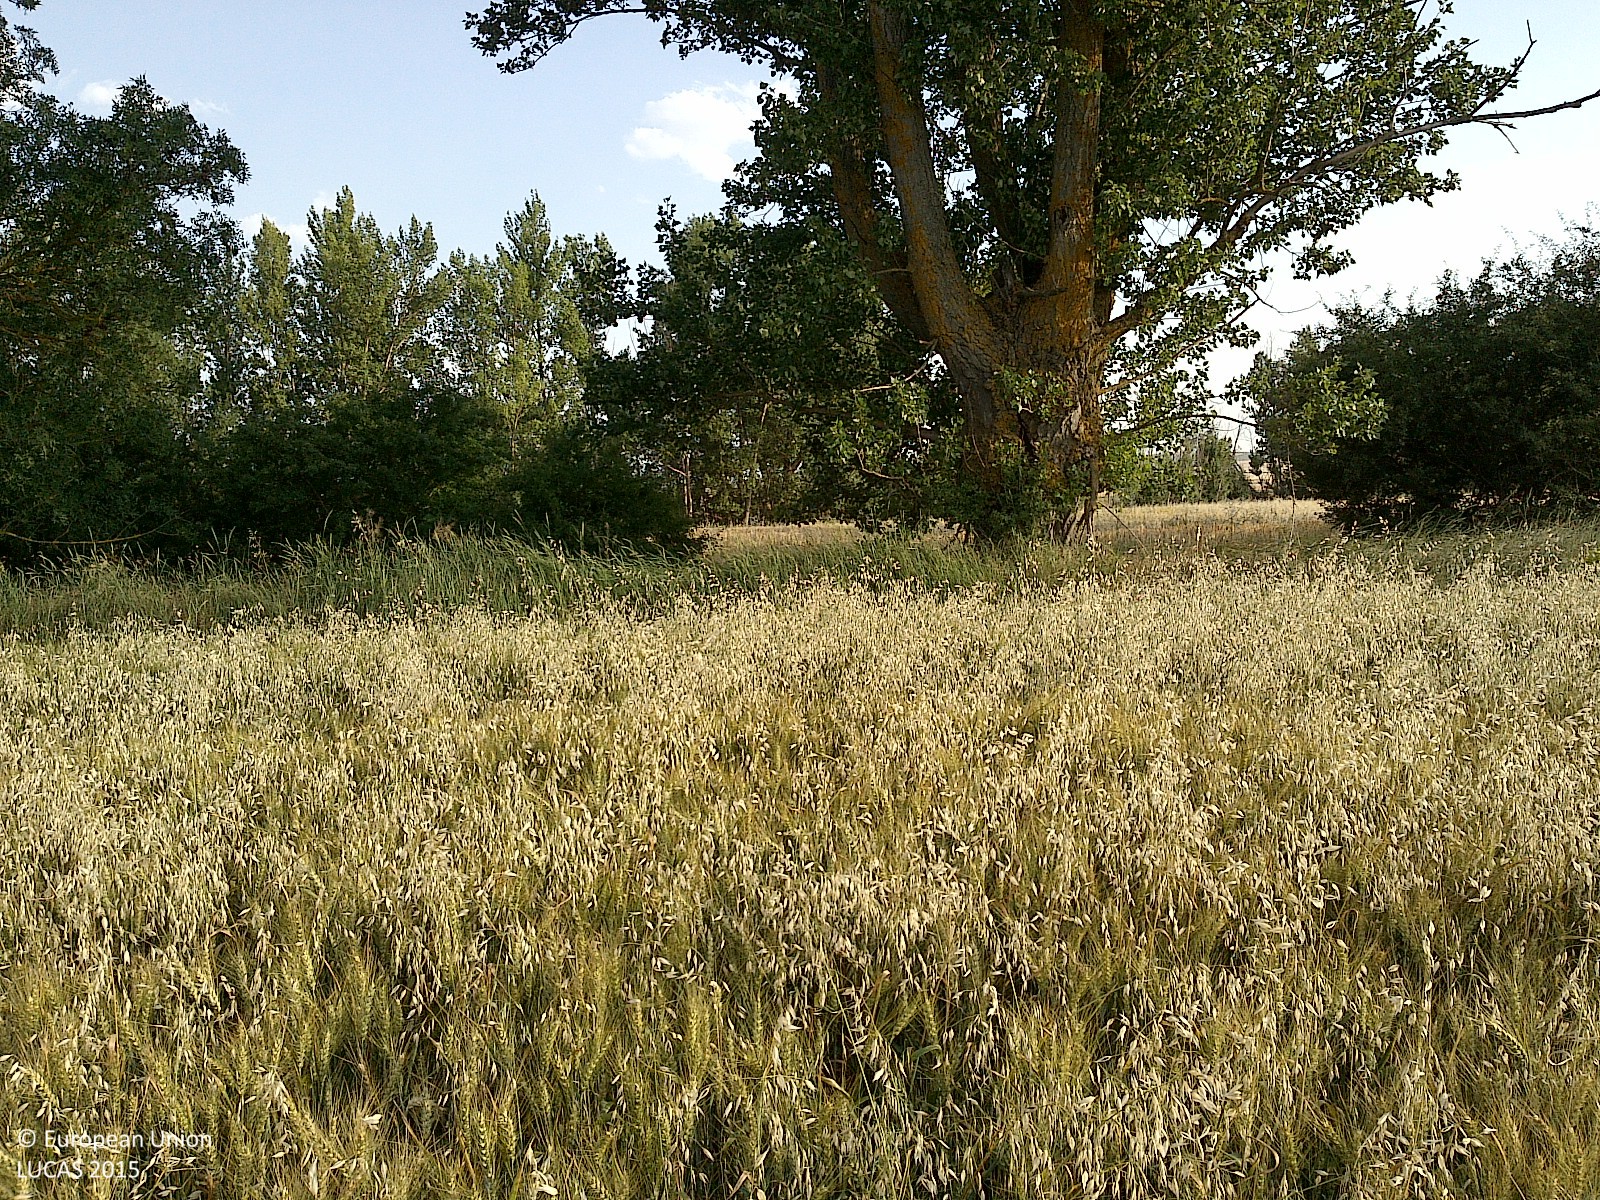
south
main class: Cropland
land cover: Durum wheat
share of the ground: > 75 %
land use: Agriculture (excluding fallow land and kitchen gardens)
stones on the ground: < 10 %
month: June
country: ES
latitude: 41.6612
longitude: -2.1751
